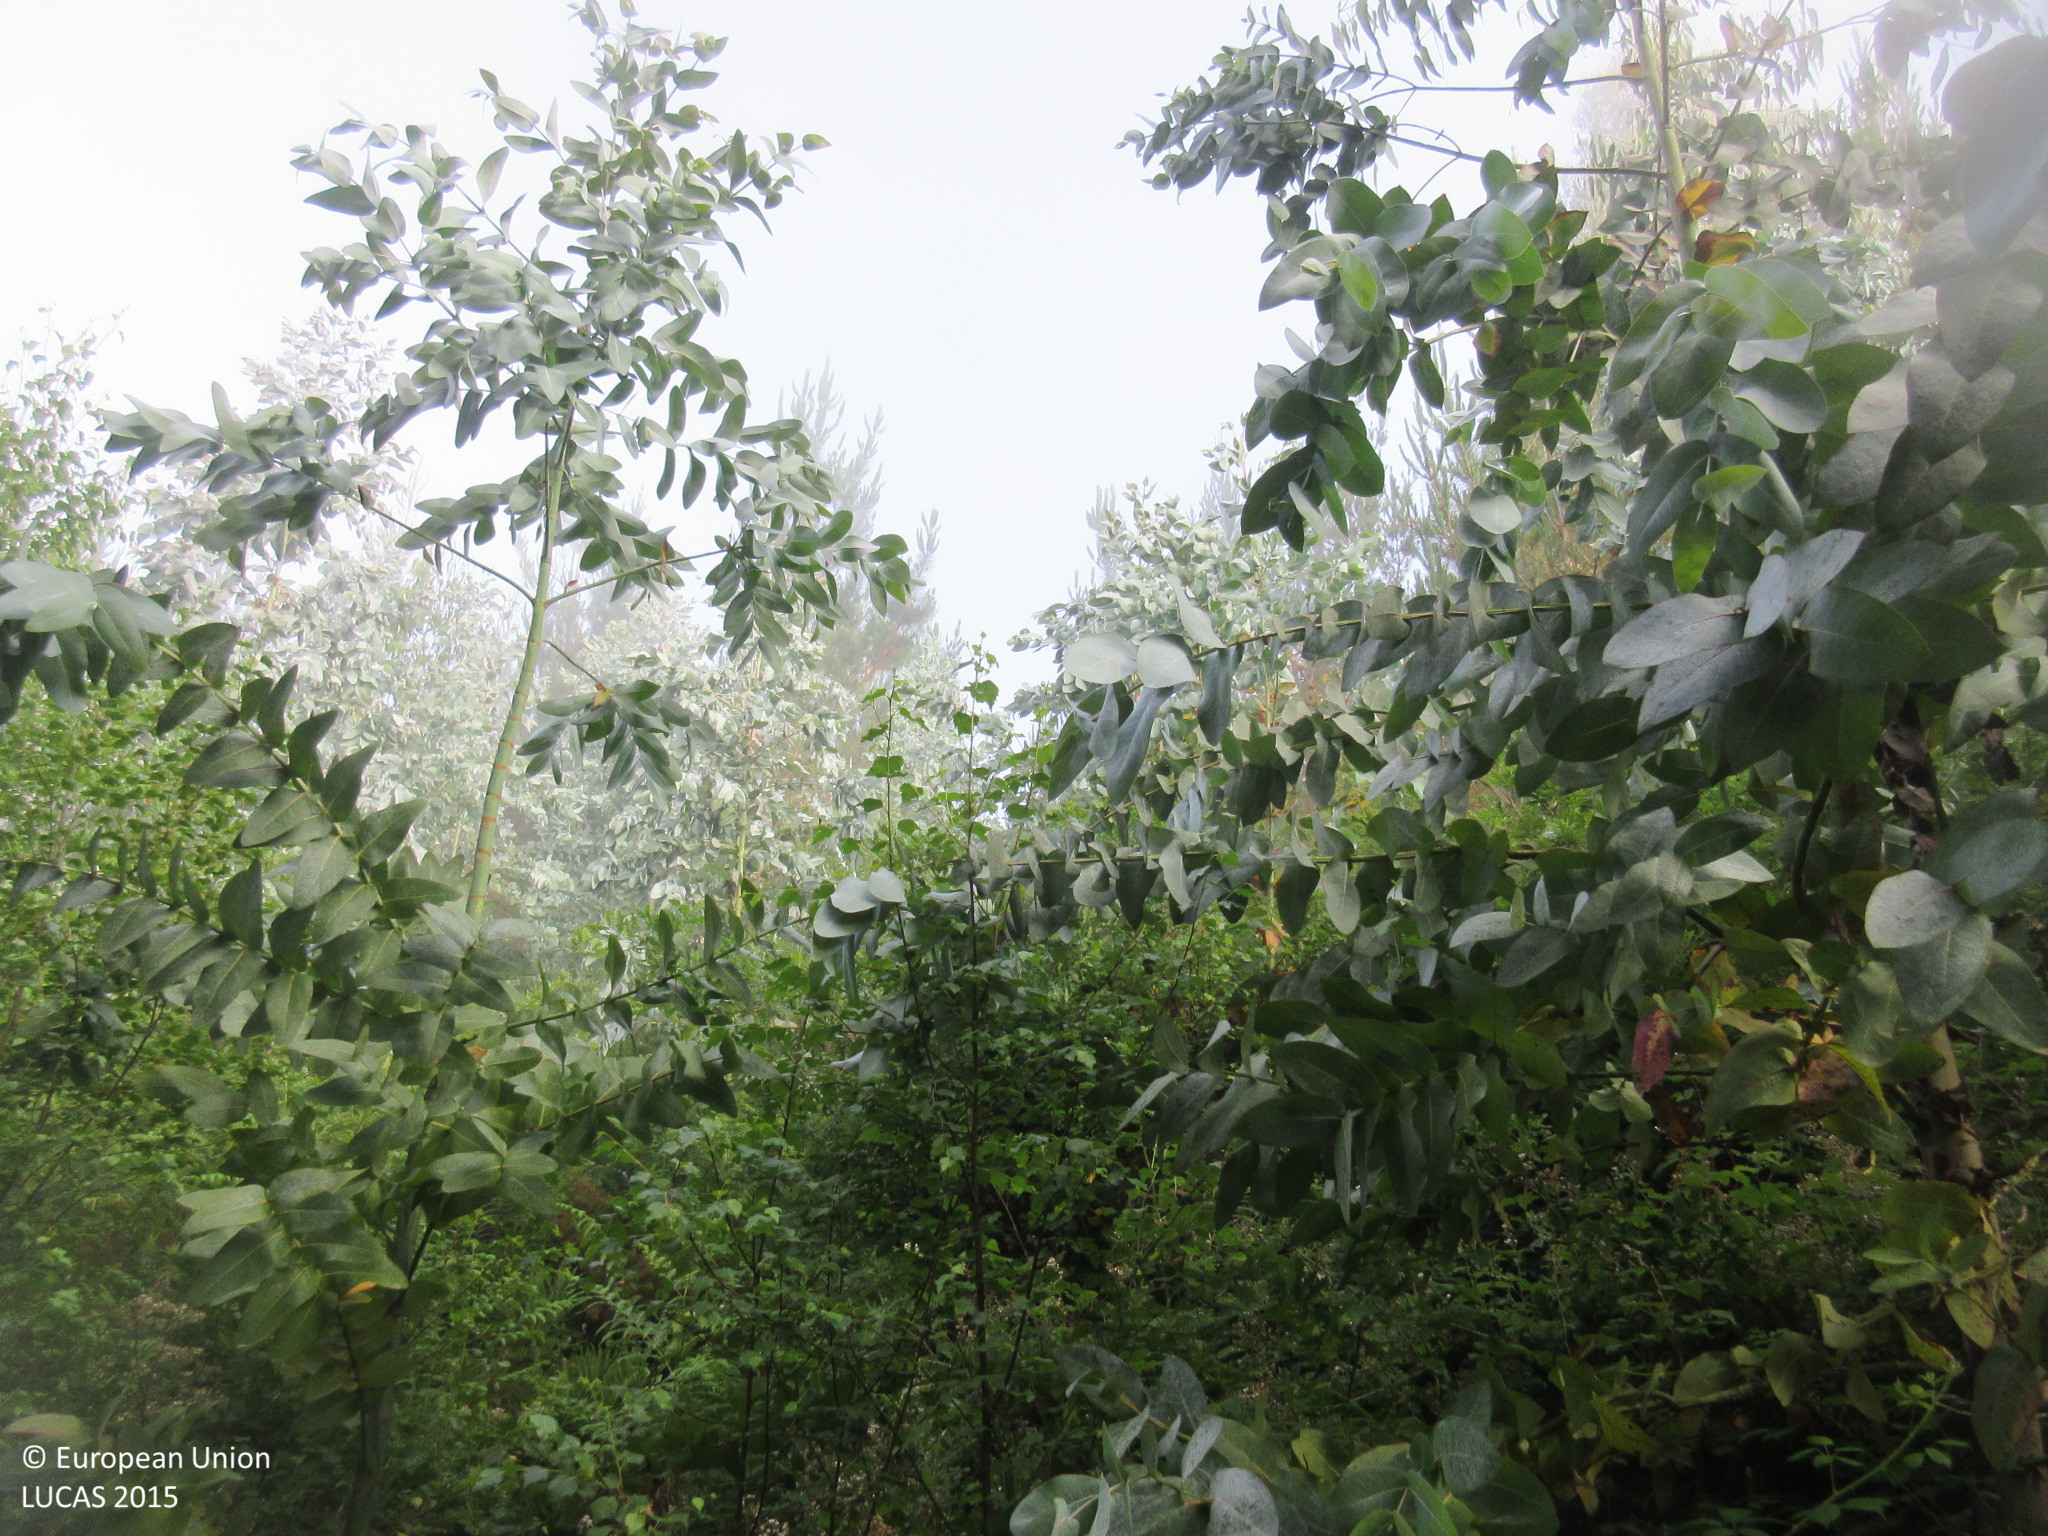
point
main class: Woodland
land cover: Broadleaved woodland
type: exotic forest
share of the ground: 50 - 75 %
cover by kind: broadleaved forest trees 70 %, shrubs 30 %
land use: Forestry
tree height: > 5 m
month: June
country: ES
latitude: 43.1307
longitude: -7.0411
